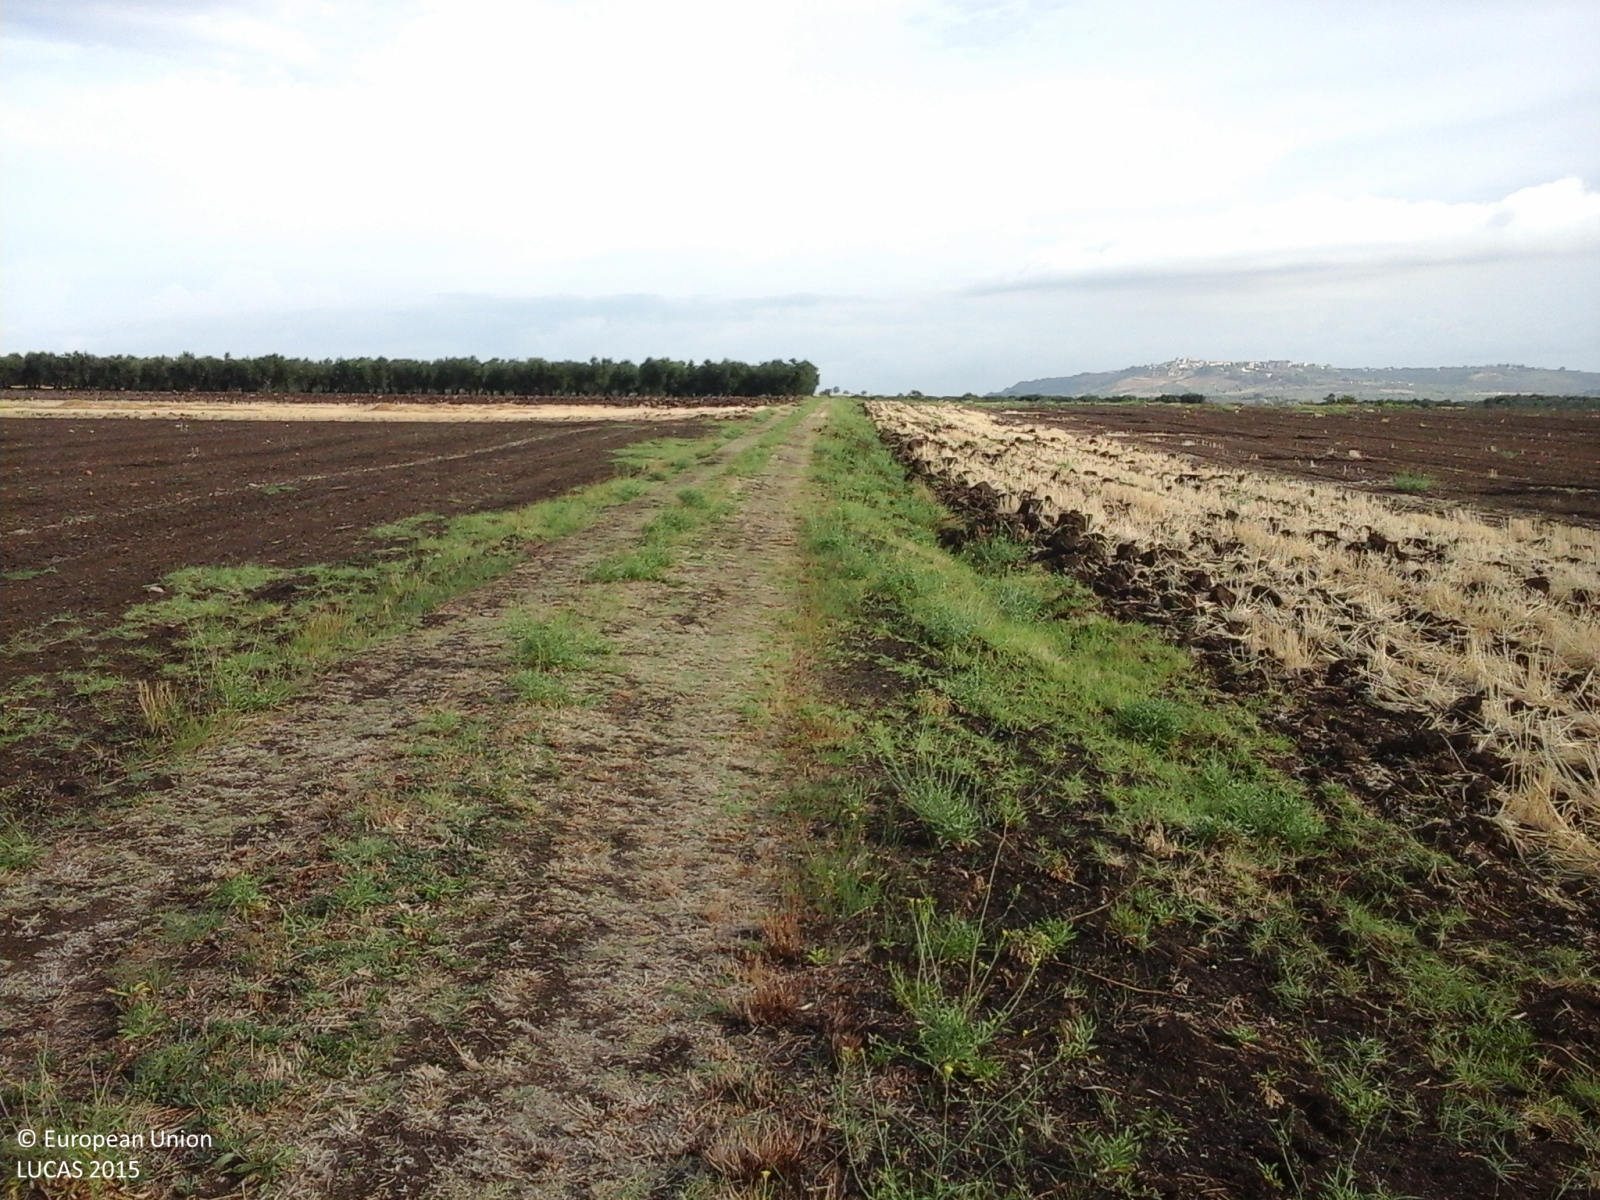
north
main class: Cropland
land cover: Durum wheat
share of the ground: > 75 %
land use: Agriculture (excluding fallow land and kitchen gardens)
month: September
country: IT
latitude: 41.7631
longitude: 15.1438
